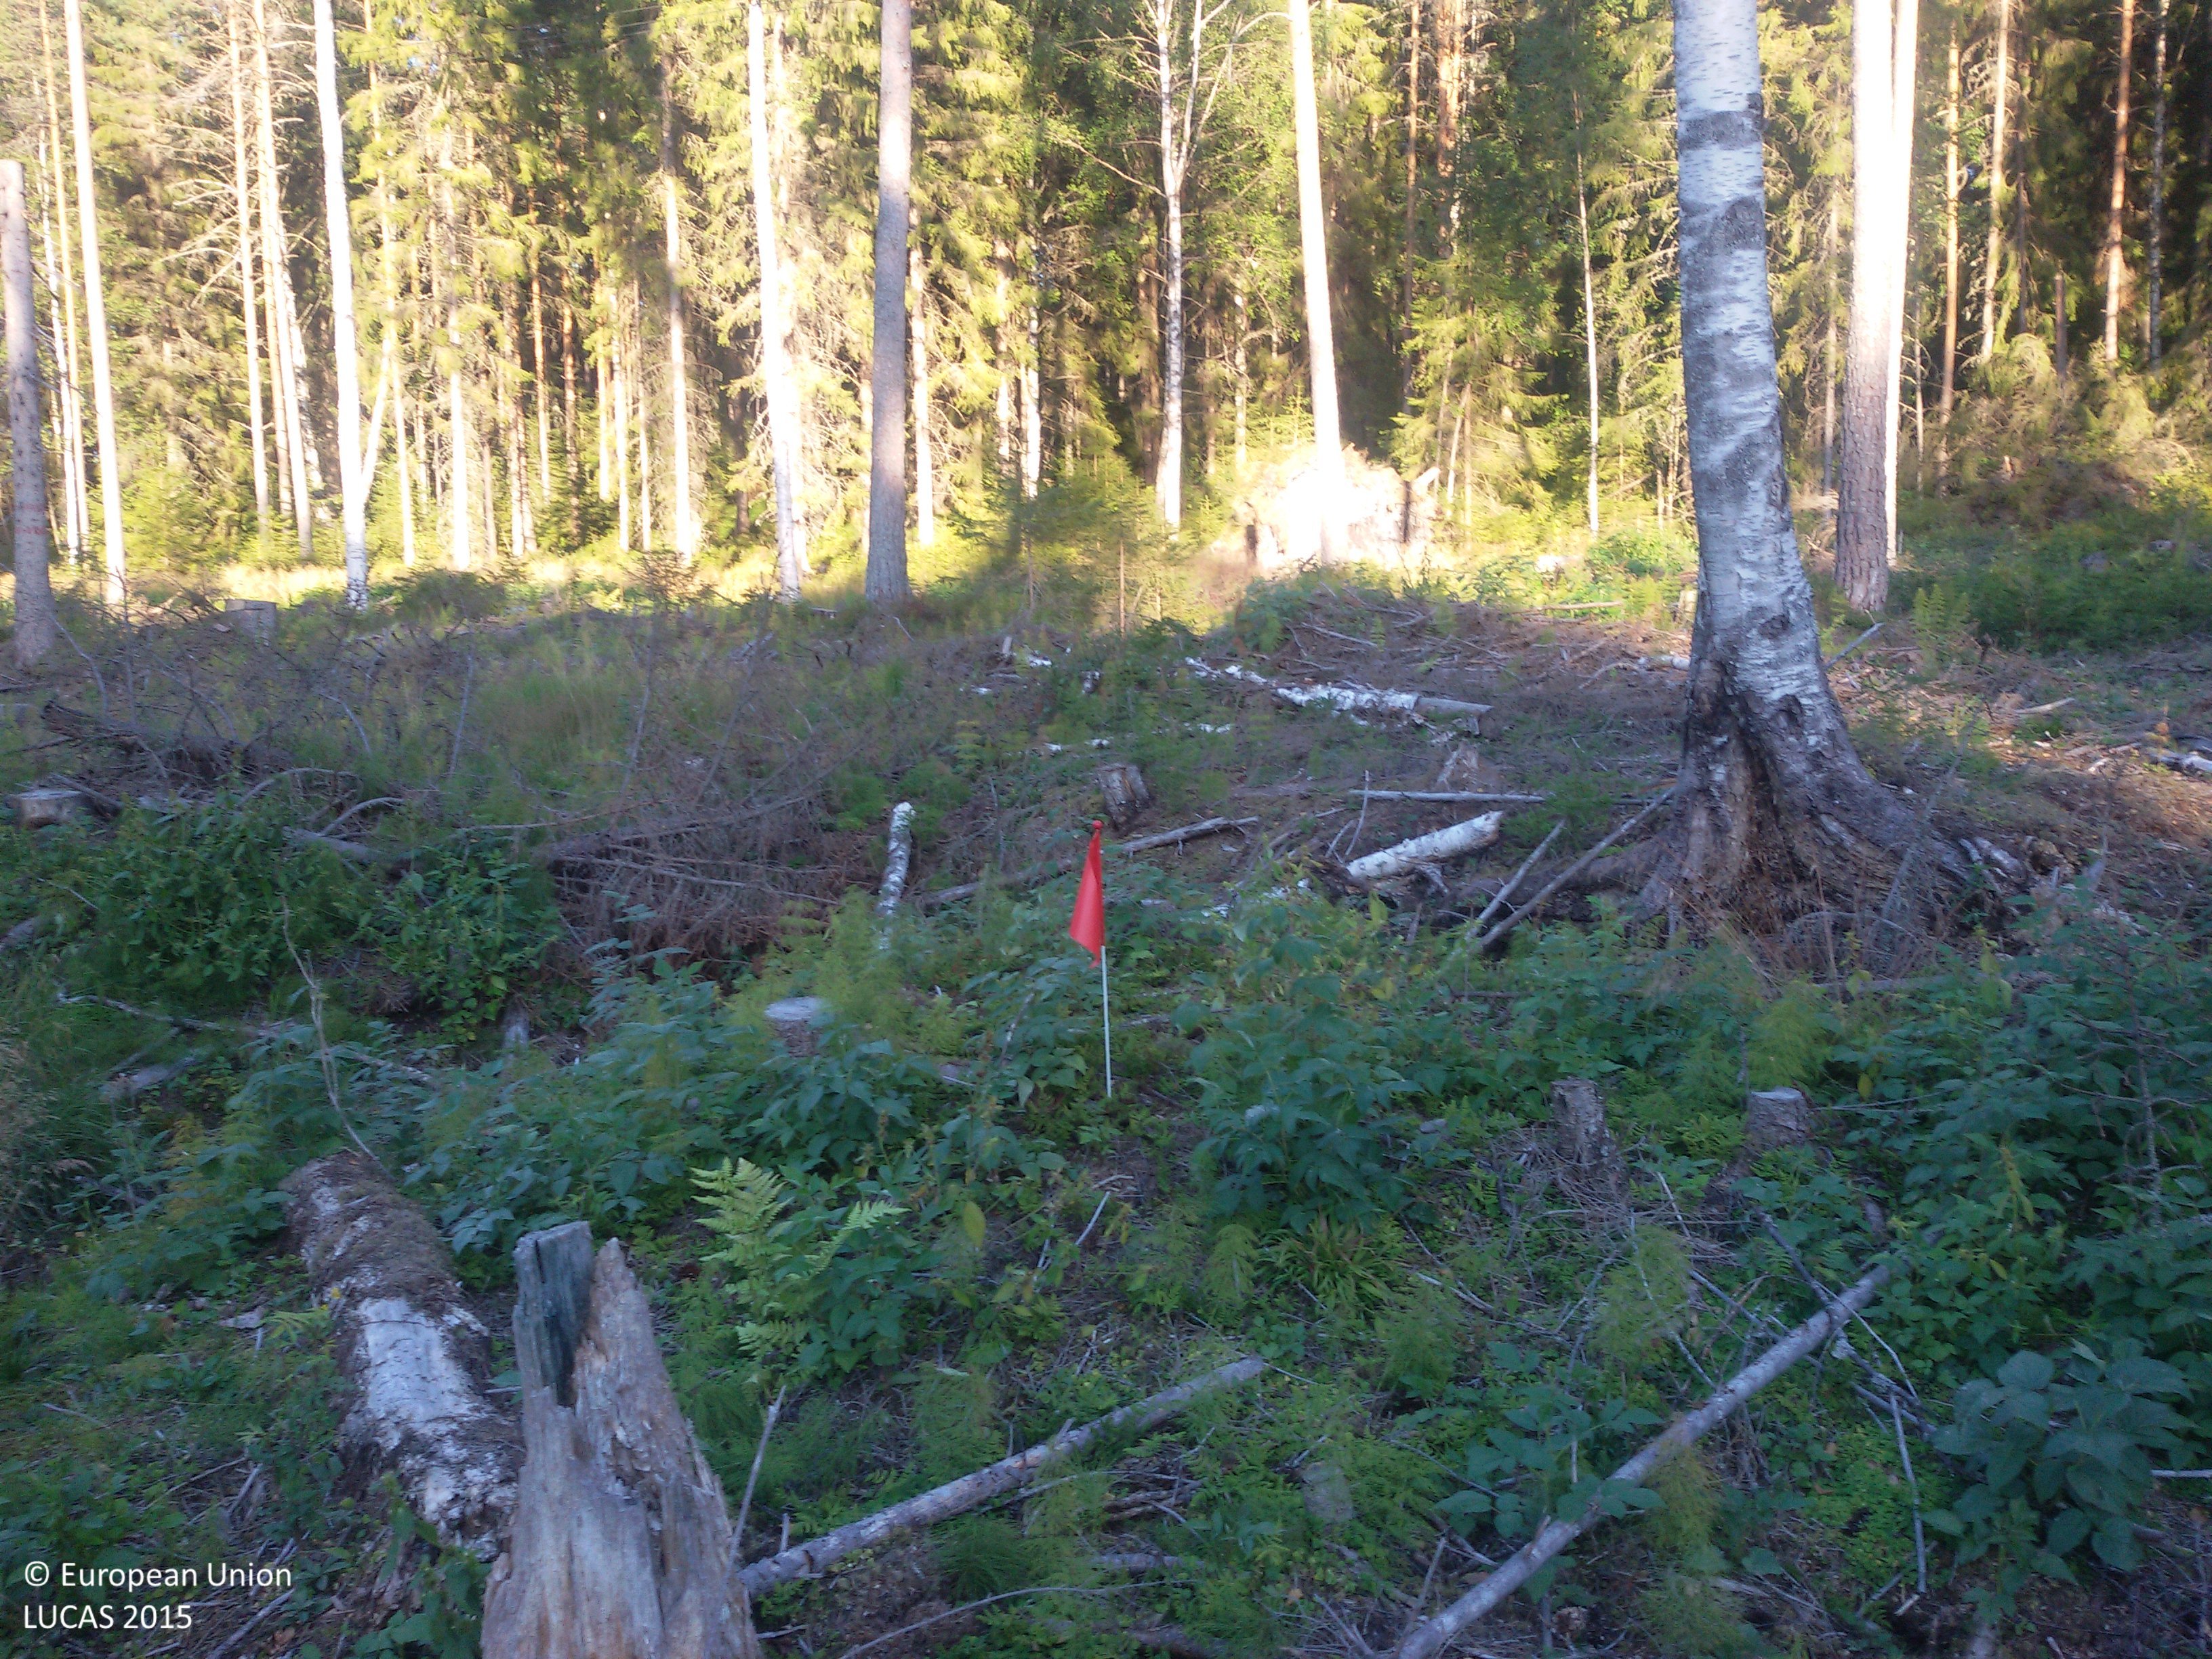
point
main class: Woodland
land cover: Pine dominated mixed woodland
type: boreal forest
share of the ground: 25 - 50 %
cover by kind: shrubs 50 %, lichens and mosses 20 %, coniferous forest trees 15 %, broadleaved forest trees 15 %
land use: Forestry
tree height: > 5 m
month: August
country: SE
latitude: 60.7102
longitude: 15.8324
